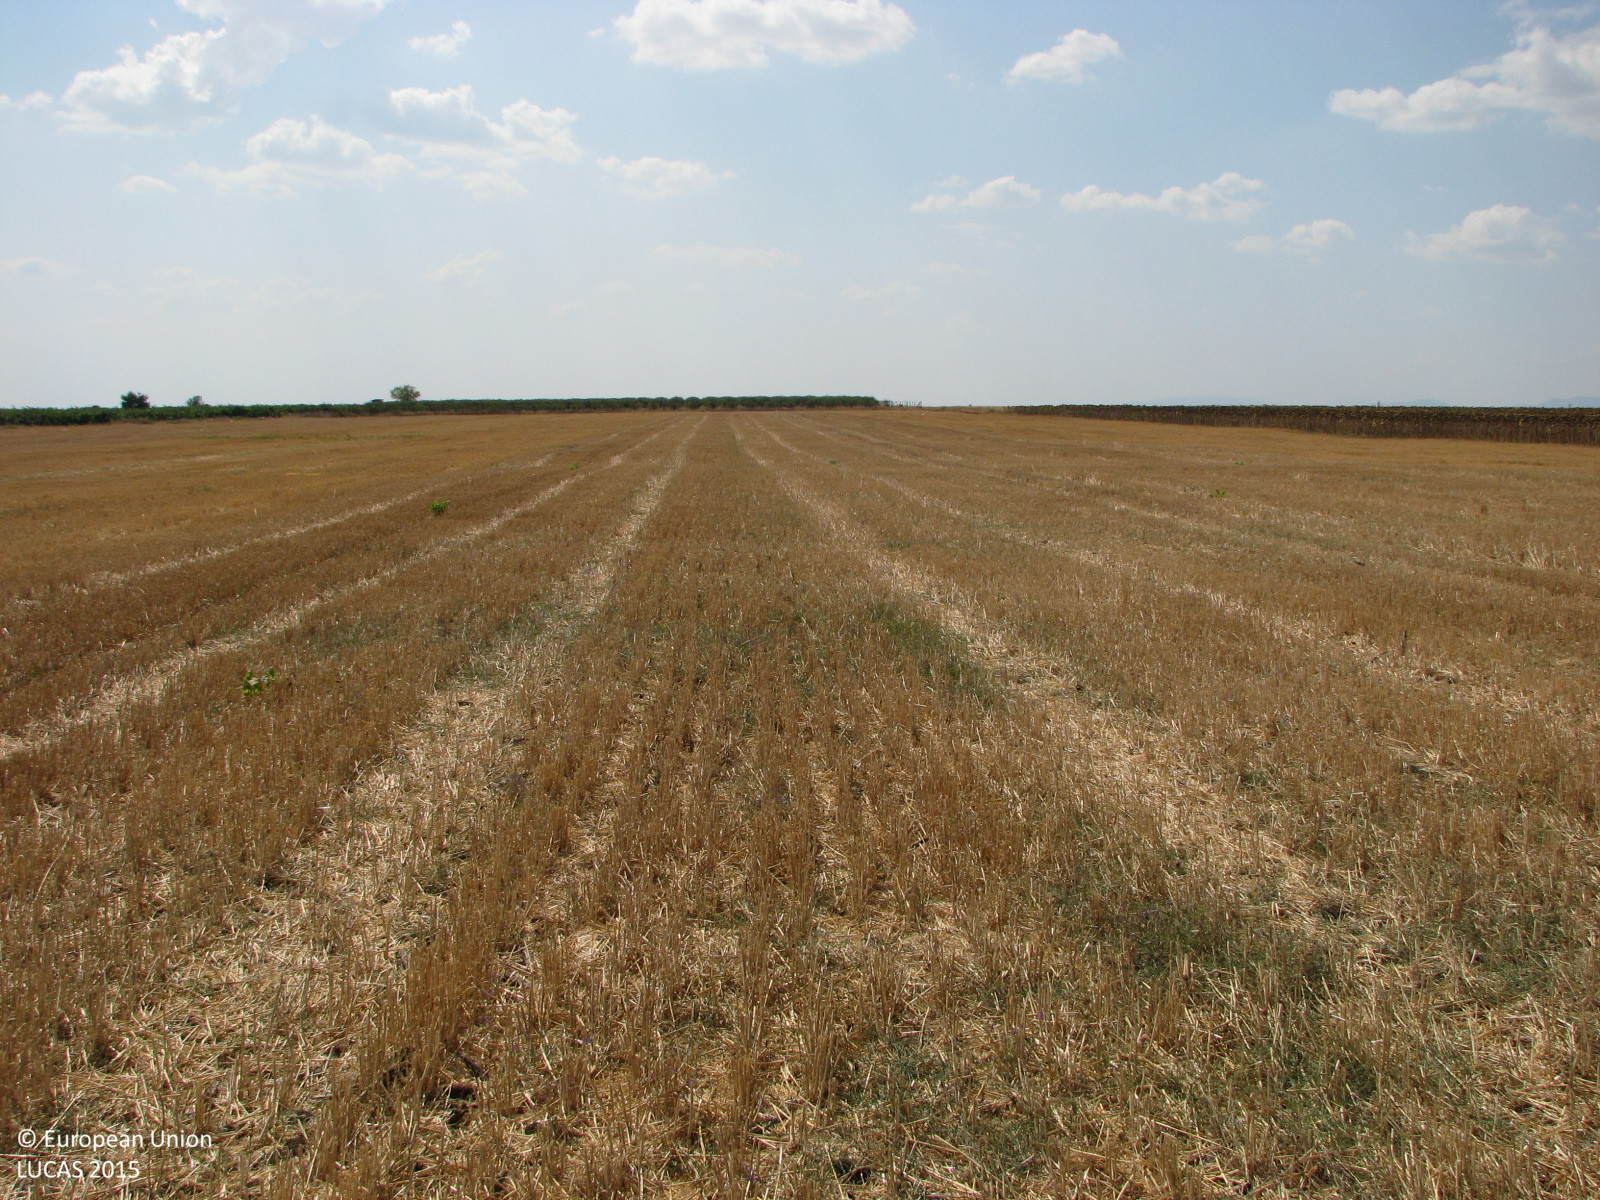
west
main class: Cropland
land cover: Common wheat
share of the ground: 50 - 75 %
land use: Agriculture (excluding fallow land and kitchen gardens)
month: August
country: BG
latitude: 42.5959
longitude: 26.6098
